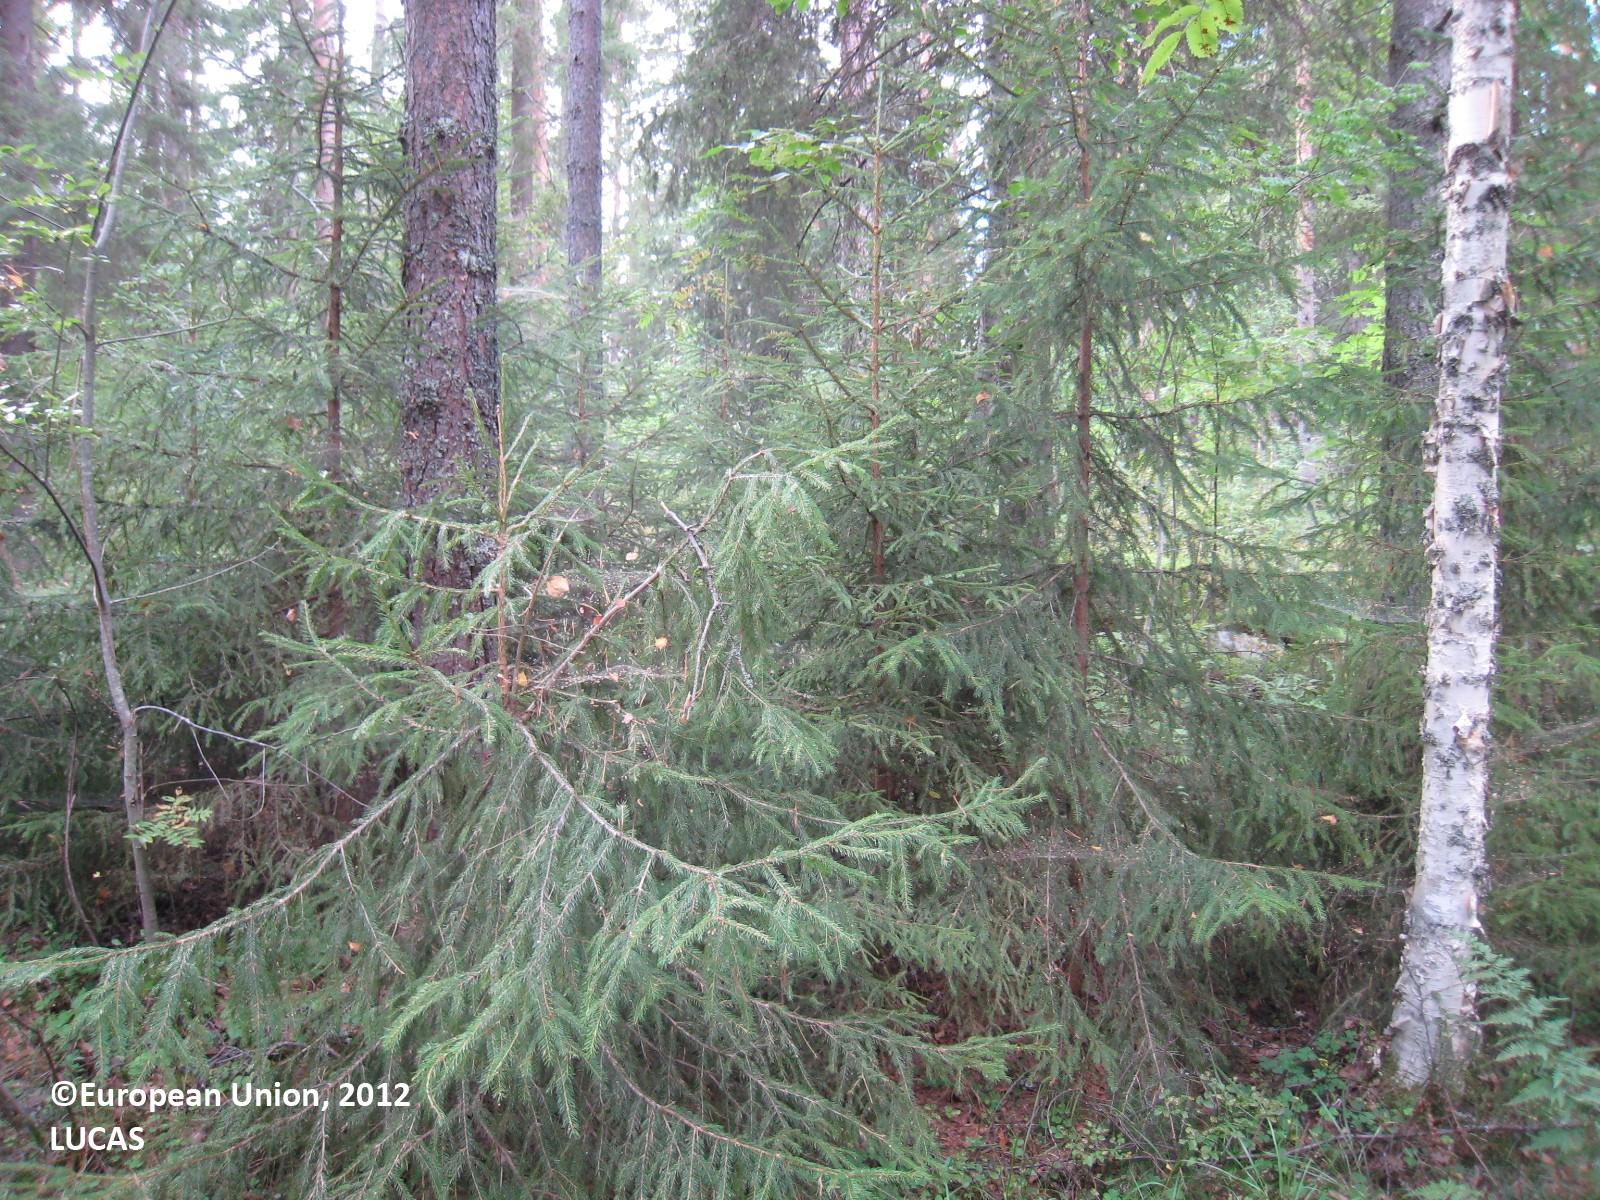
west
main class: Woodland
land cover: Other mixed woodland
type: boreal forest
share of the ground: > 75 %
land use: Forestry
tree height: > 5 m
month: August
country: FI
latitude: 62.0285
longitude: 27.2700
